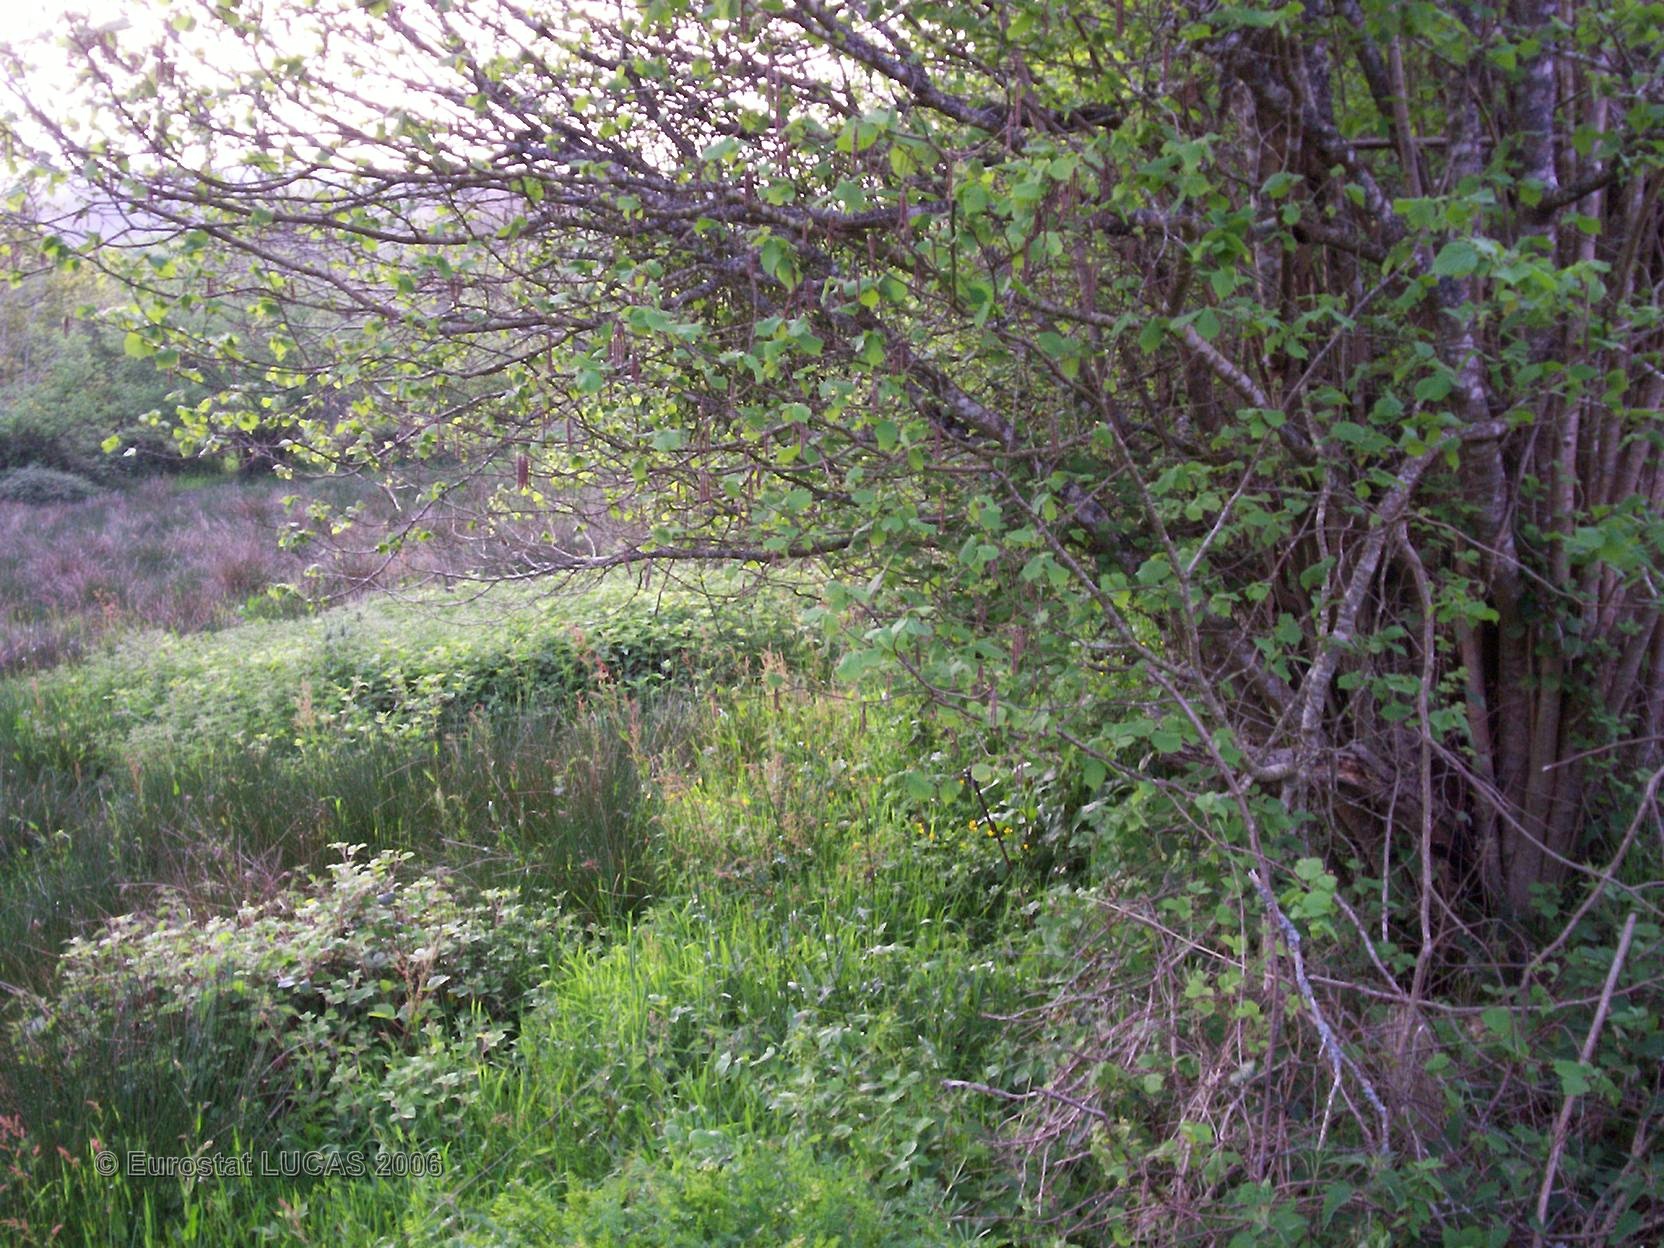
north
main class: Grassland
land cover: Grassland without tree/shrub cover
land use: Agriculture (excluding fallow land and kitchen gardens)
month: May
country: FR
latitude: 48.1568
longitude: -3.9185
